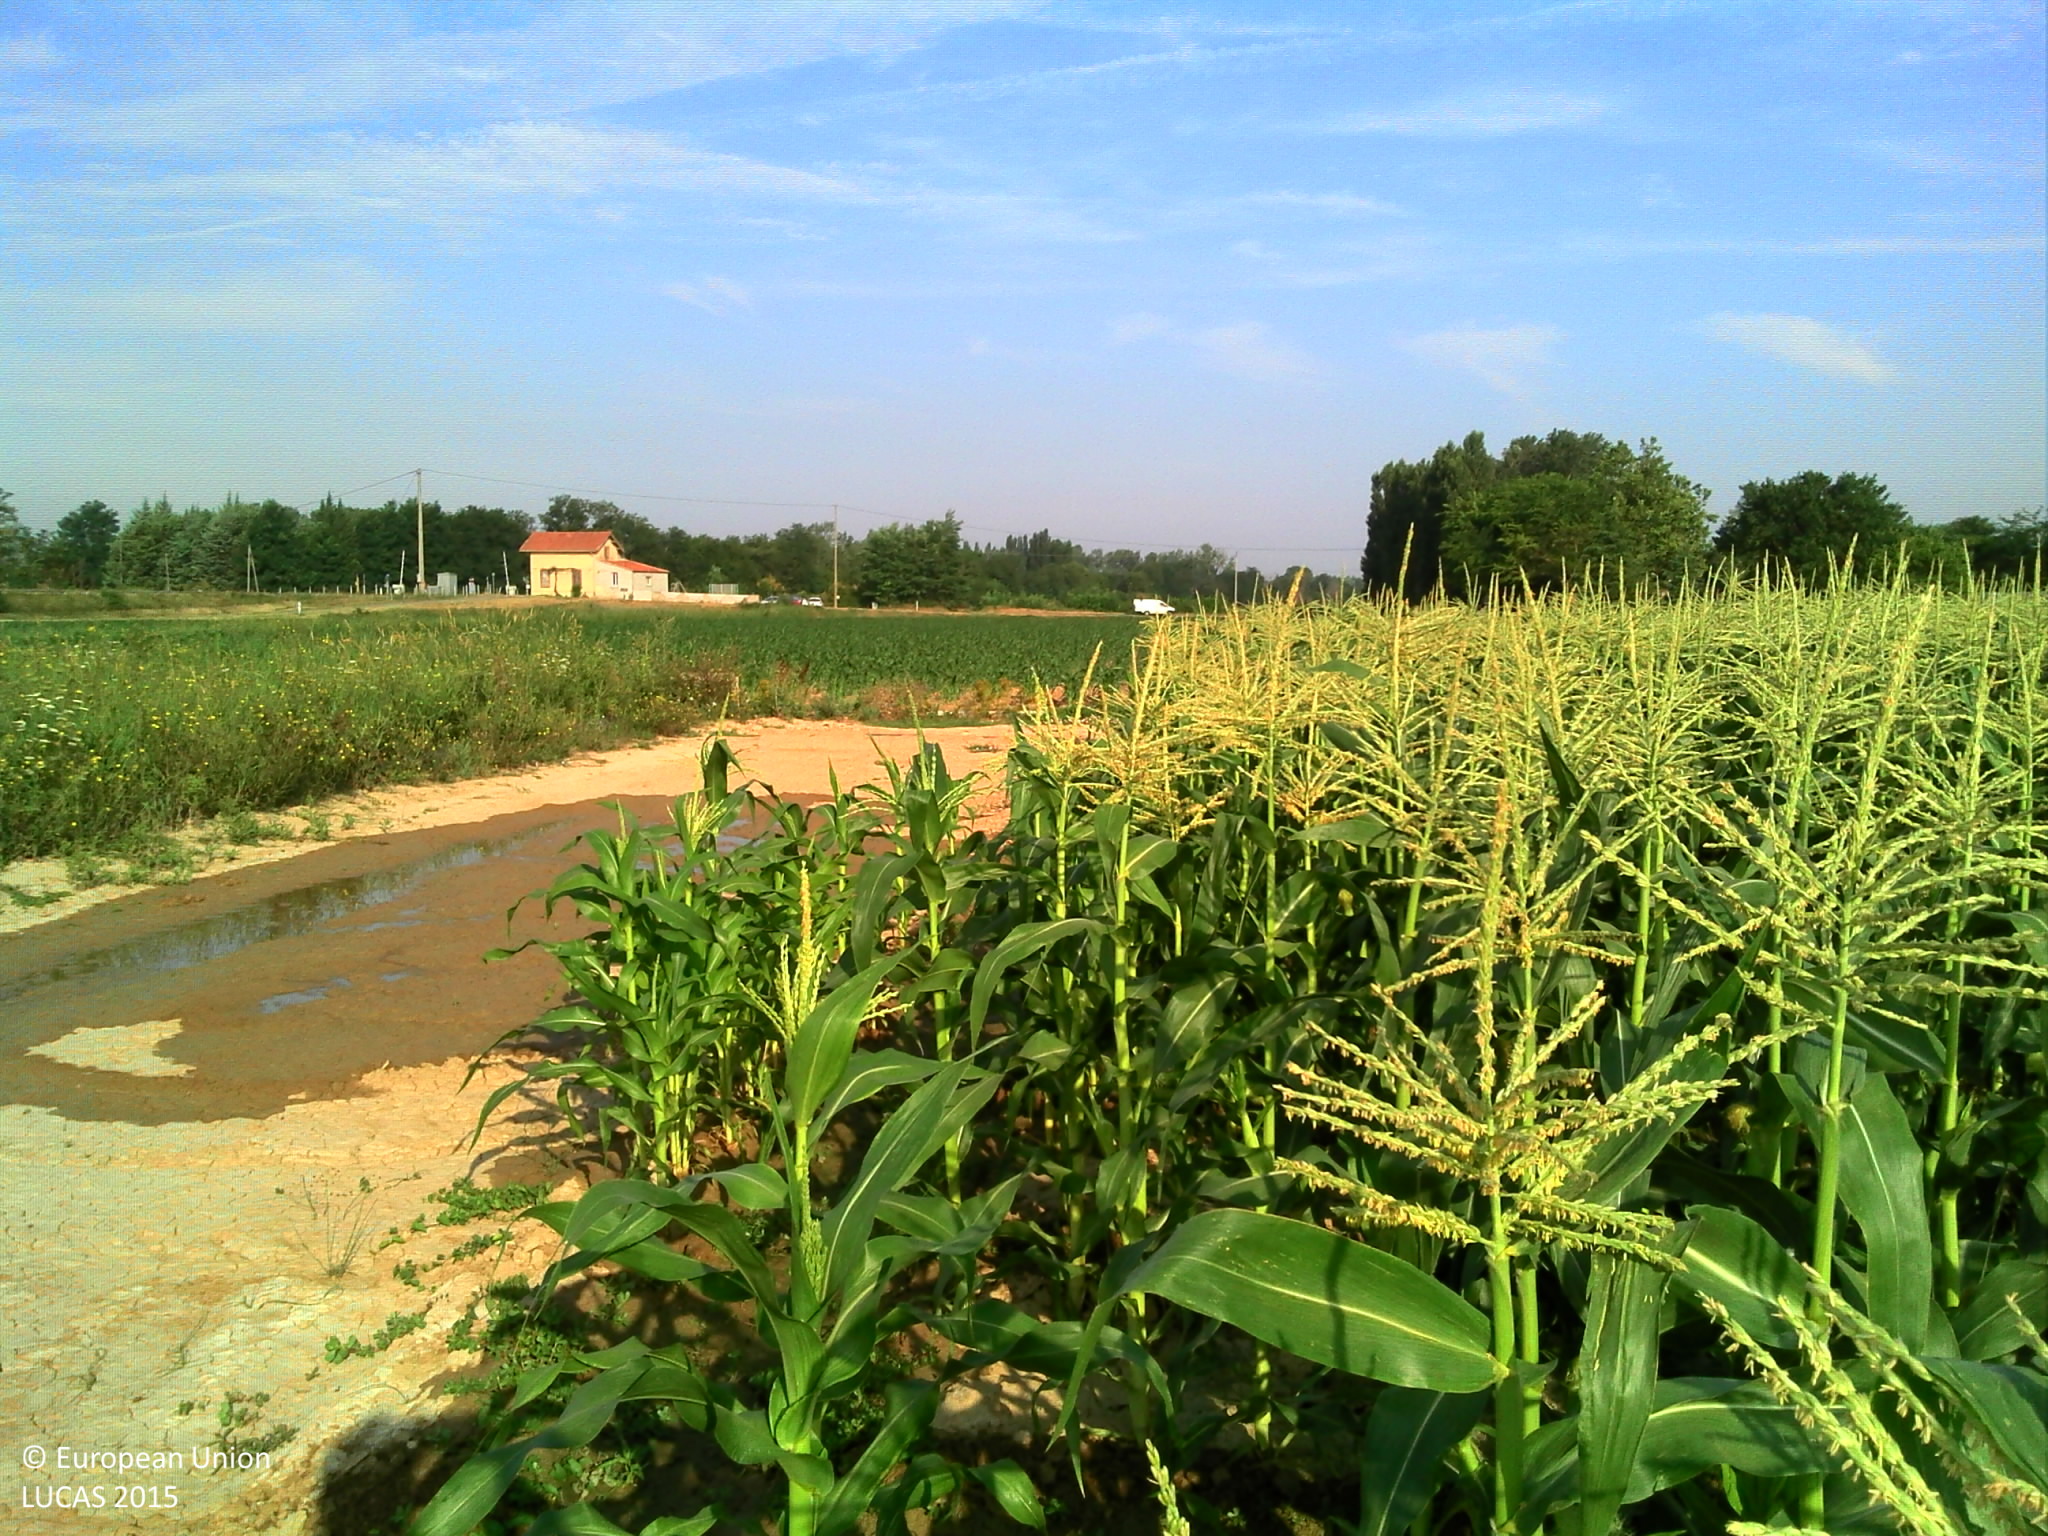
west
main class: Cropland
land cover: Maize
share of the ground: > 75 %
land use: Agriculture (excluding fallow land and kitchen gardens)
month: July
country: FR
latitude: 43.6762
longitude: 5.5315
